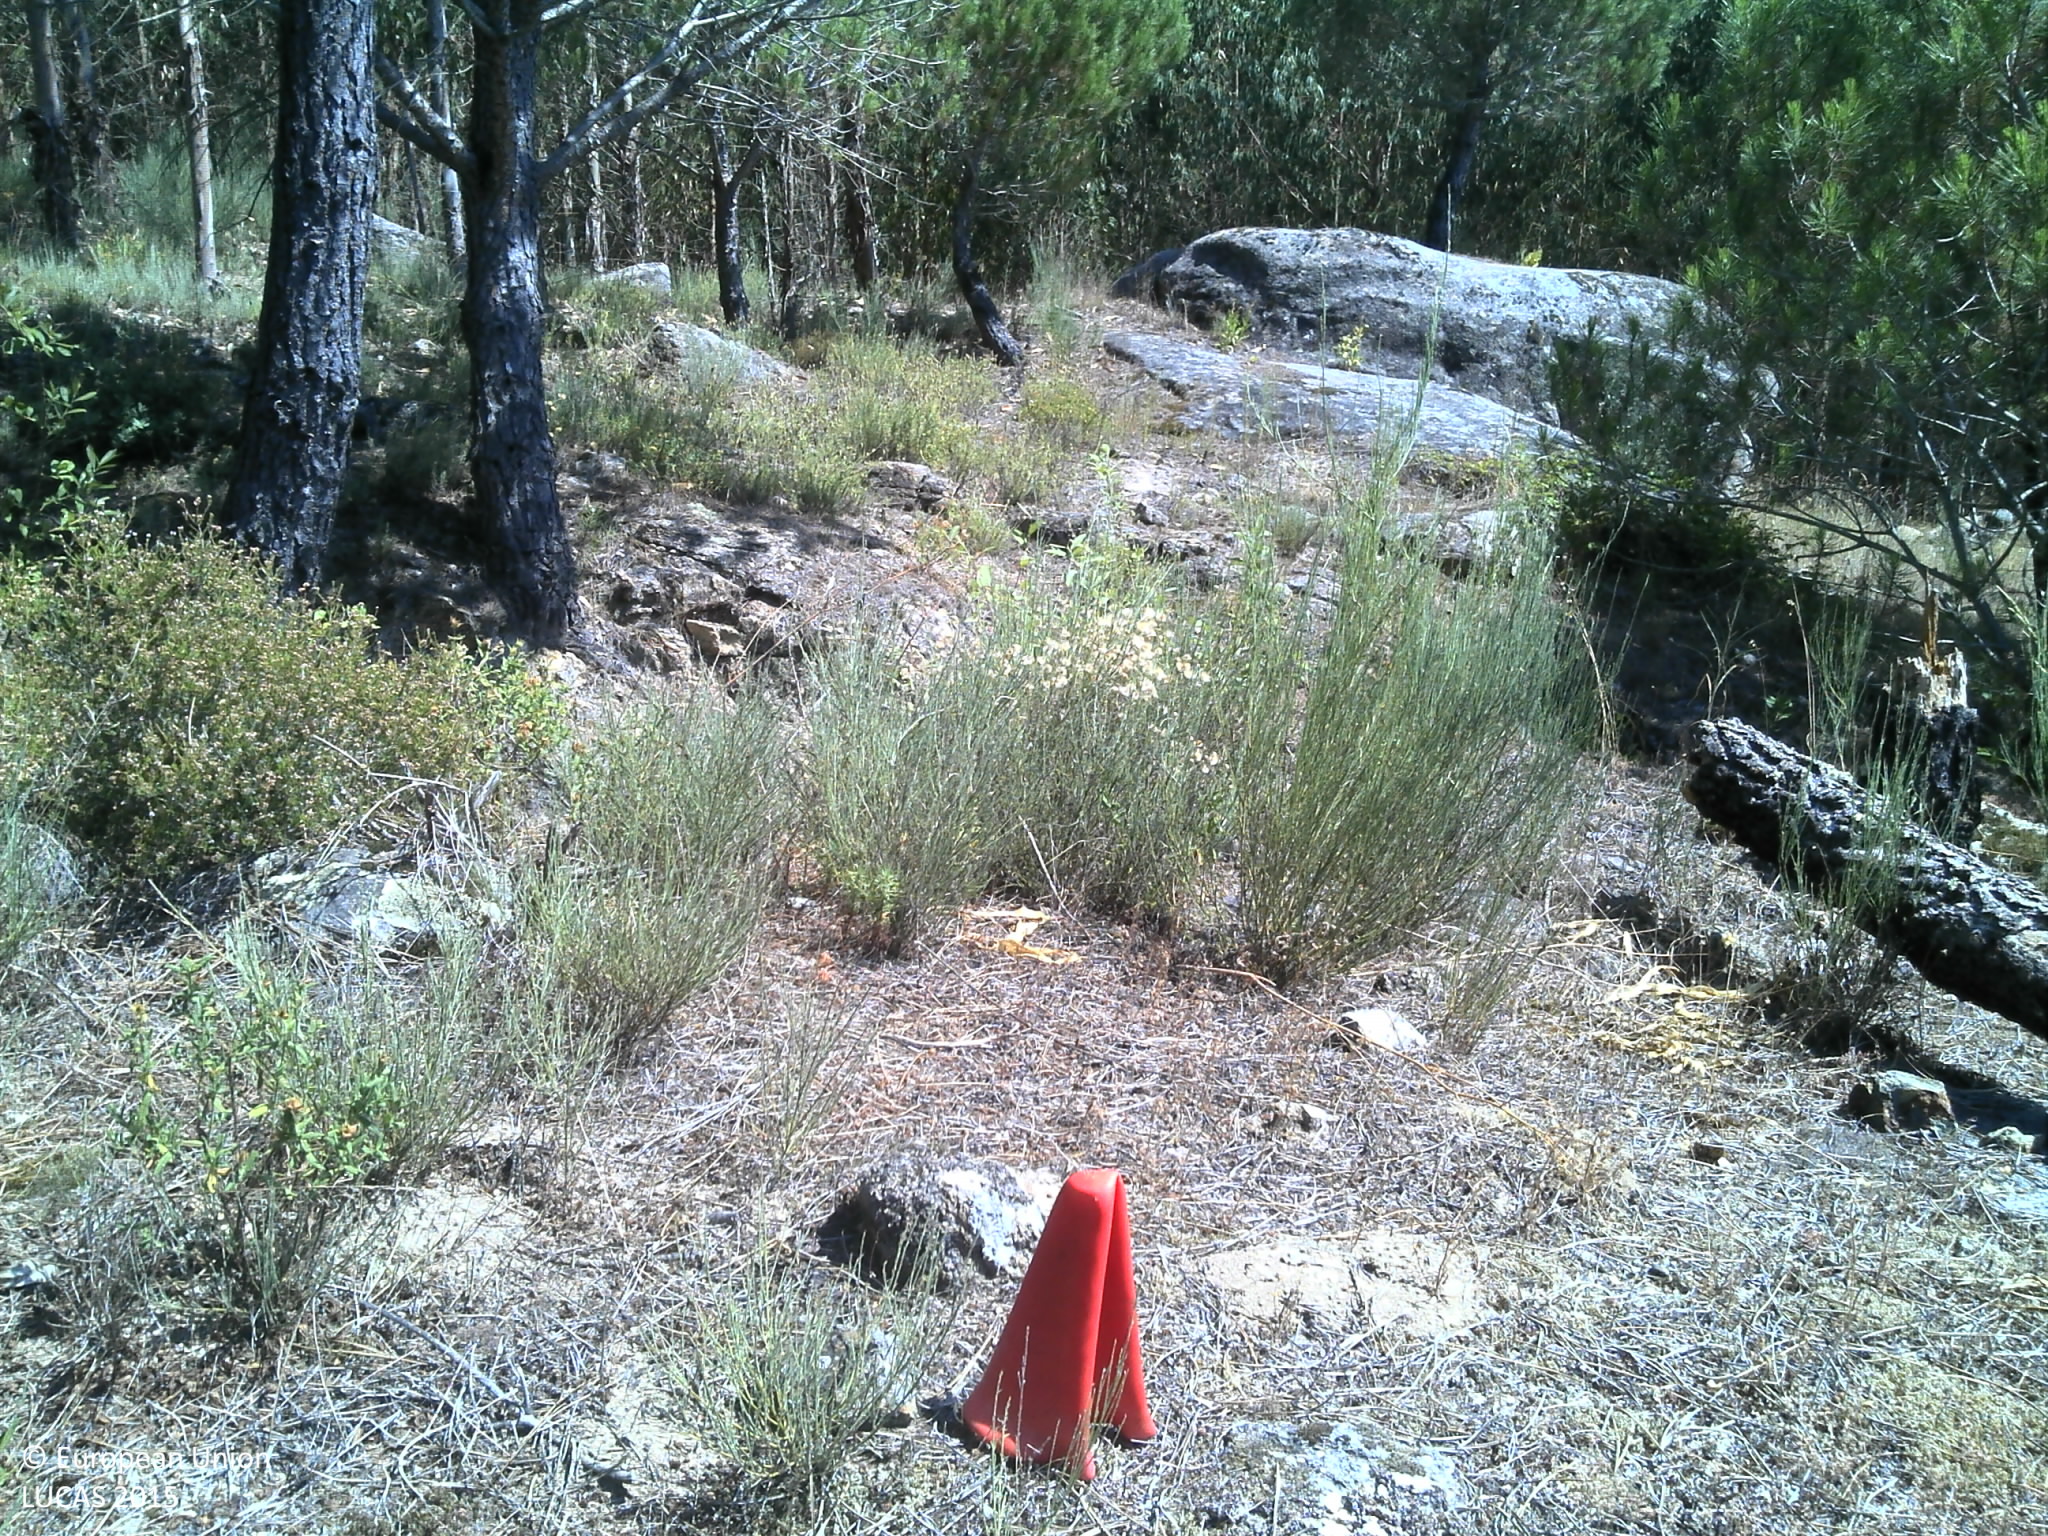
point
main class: Woodland
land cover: Pine dominated coniferous woodland
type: coniferous forest of the mediterranean region
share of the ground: 25 - 50 %
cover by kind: coniferous forest trees 45 %, herbaceous plants 25 %, shrubs 10 %, consolidated bare surface 10 %, unconsolidated bare surface 10 %
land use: Forestry
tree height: > 5 m
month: June
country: PT
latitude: 40.5329
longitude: -7.7677
